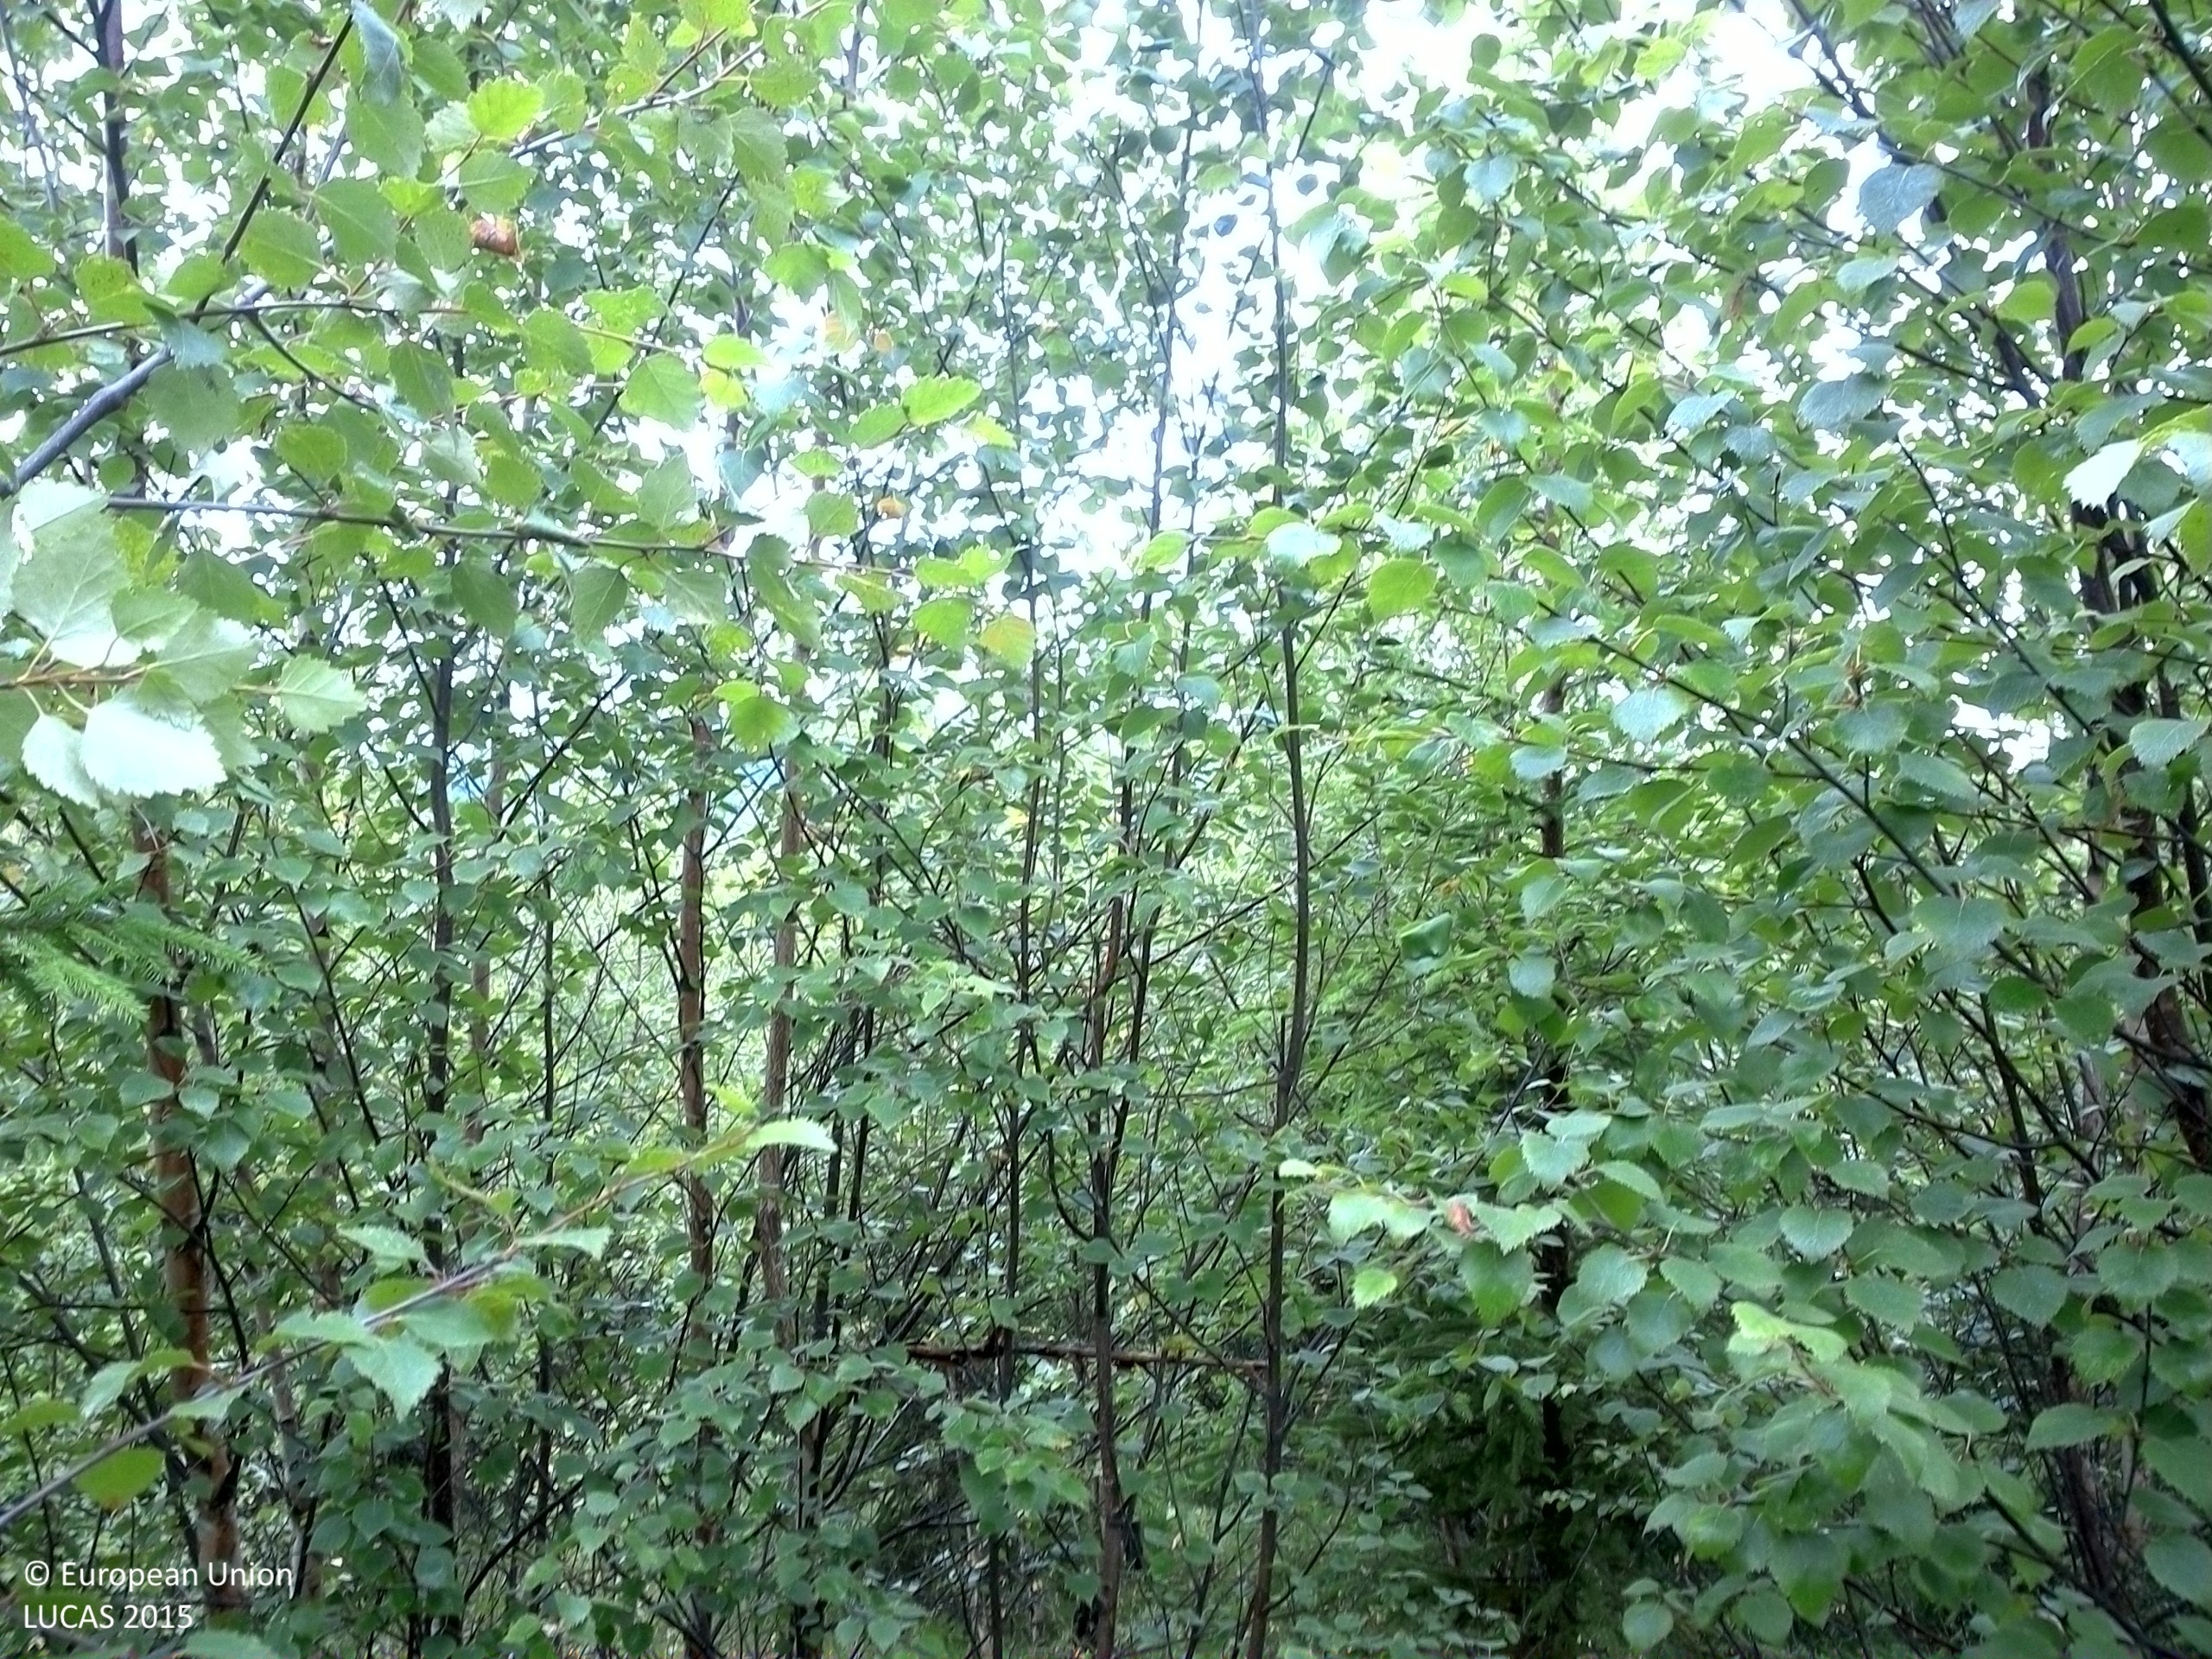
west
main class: Woodland
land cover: Spruce dominated mixed woodland
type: boreal forest
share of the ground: > 75 %
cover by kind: coniferous forest trees 45 %, broadleaved forest trees 35 %, herbaceous plants 15 %, shrubs 5 %
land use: Forestry
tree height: < 5 m
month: July
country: SE
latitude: 62.6566
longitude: 17.2188
